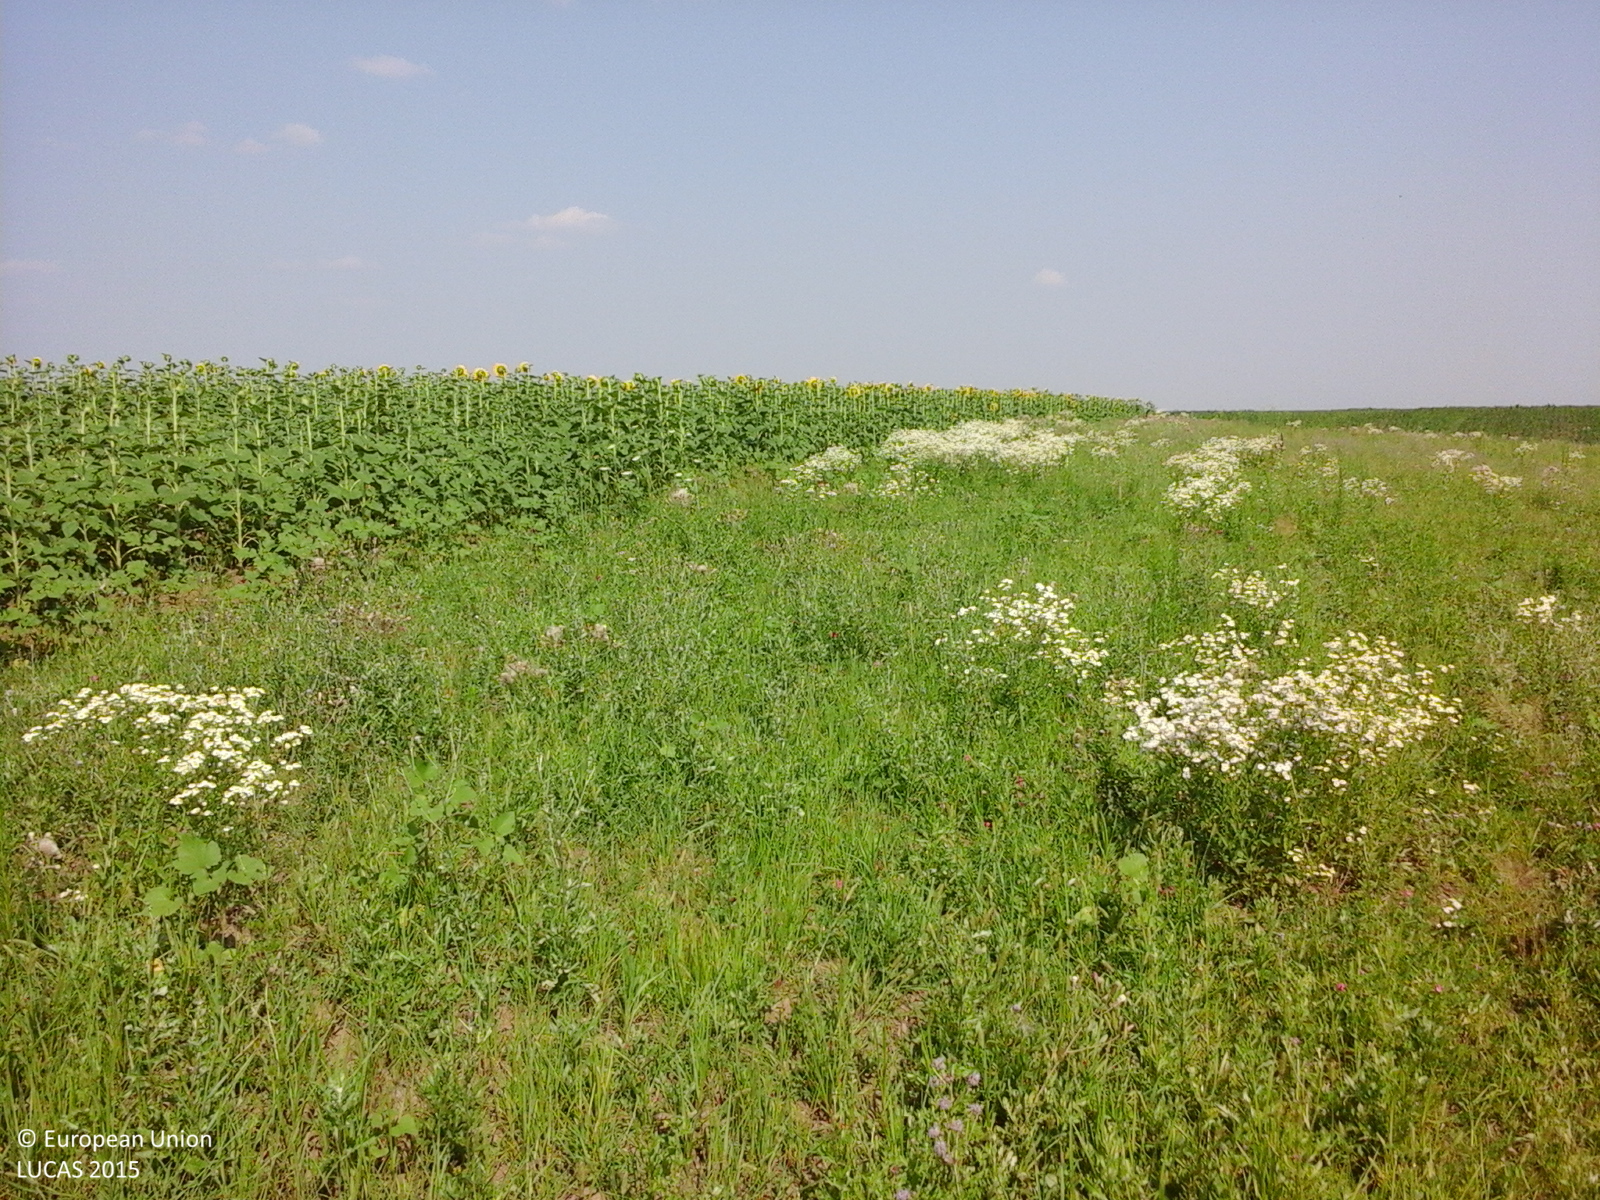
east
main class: Grassland
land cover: Spontaneously vegetated surfaces
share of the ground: > 75 %
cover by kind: herbaceous plants 100 %
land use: Fallow land
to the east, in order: Spontaneously vegetated surfaces; Sunflower; Tracks; Maize; Sunflower
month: July
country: RO
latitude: 44.5907
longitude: 25.3693
